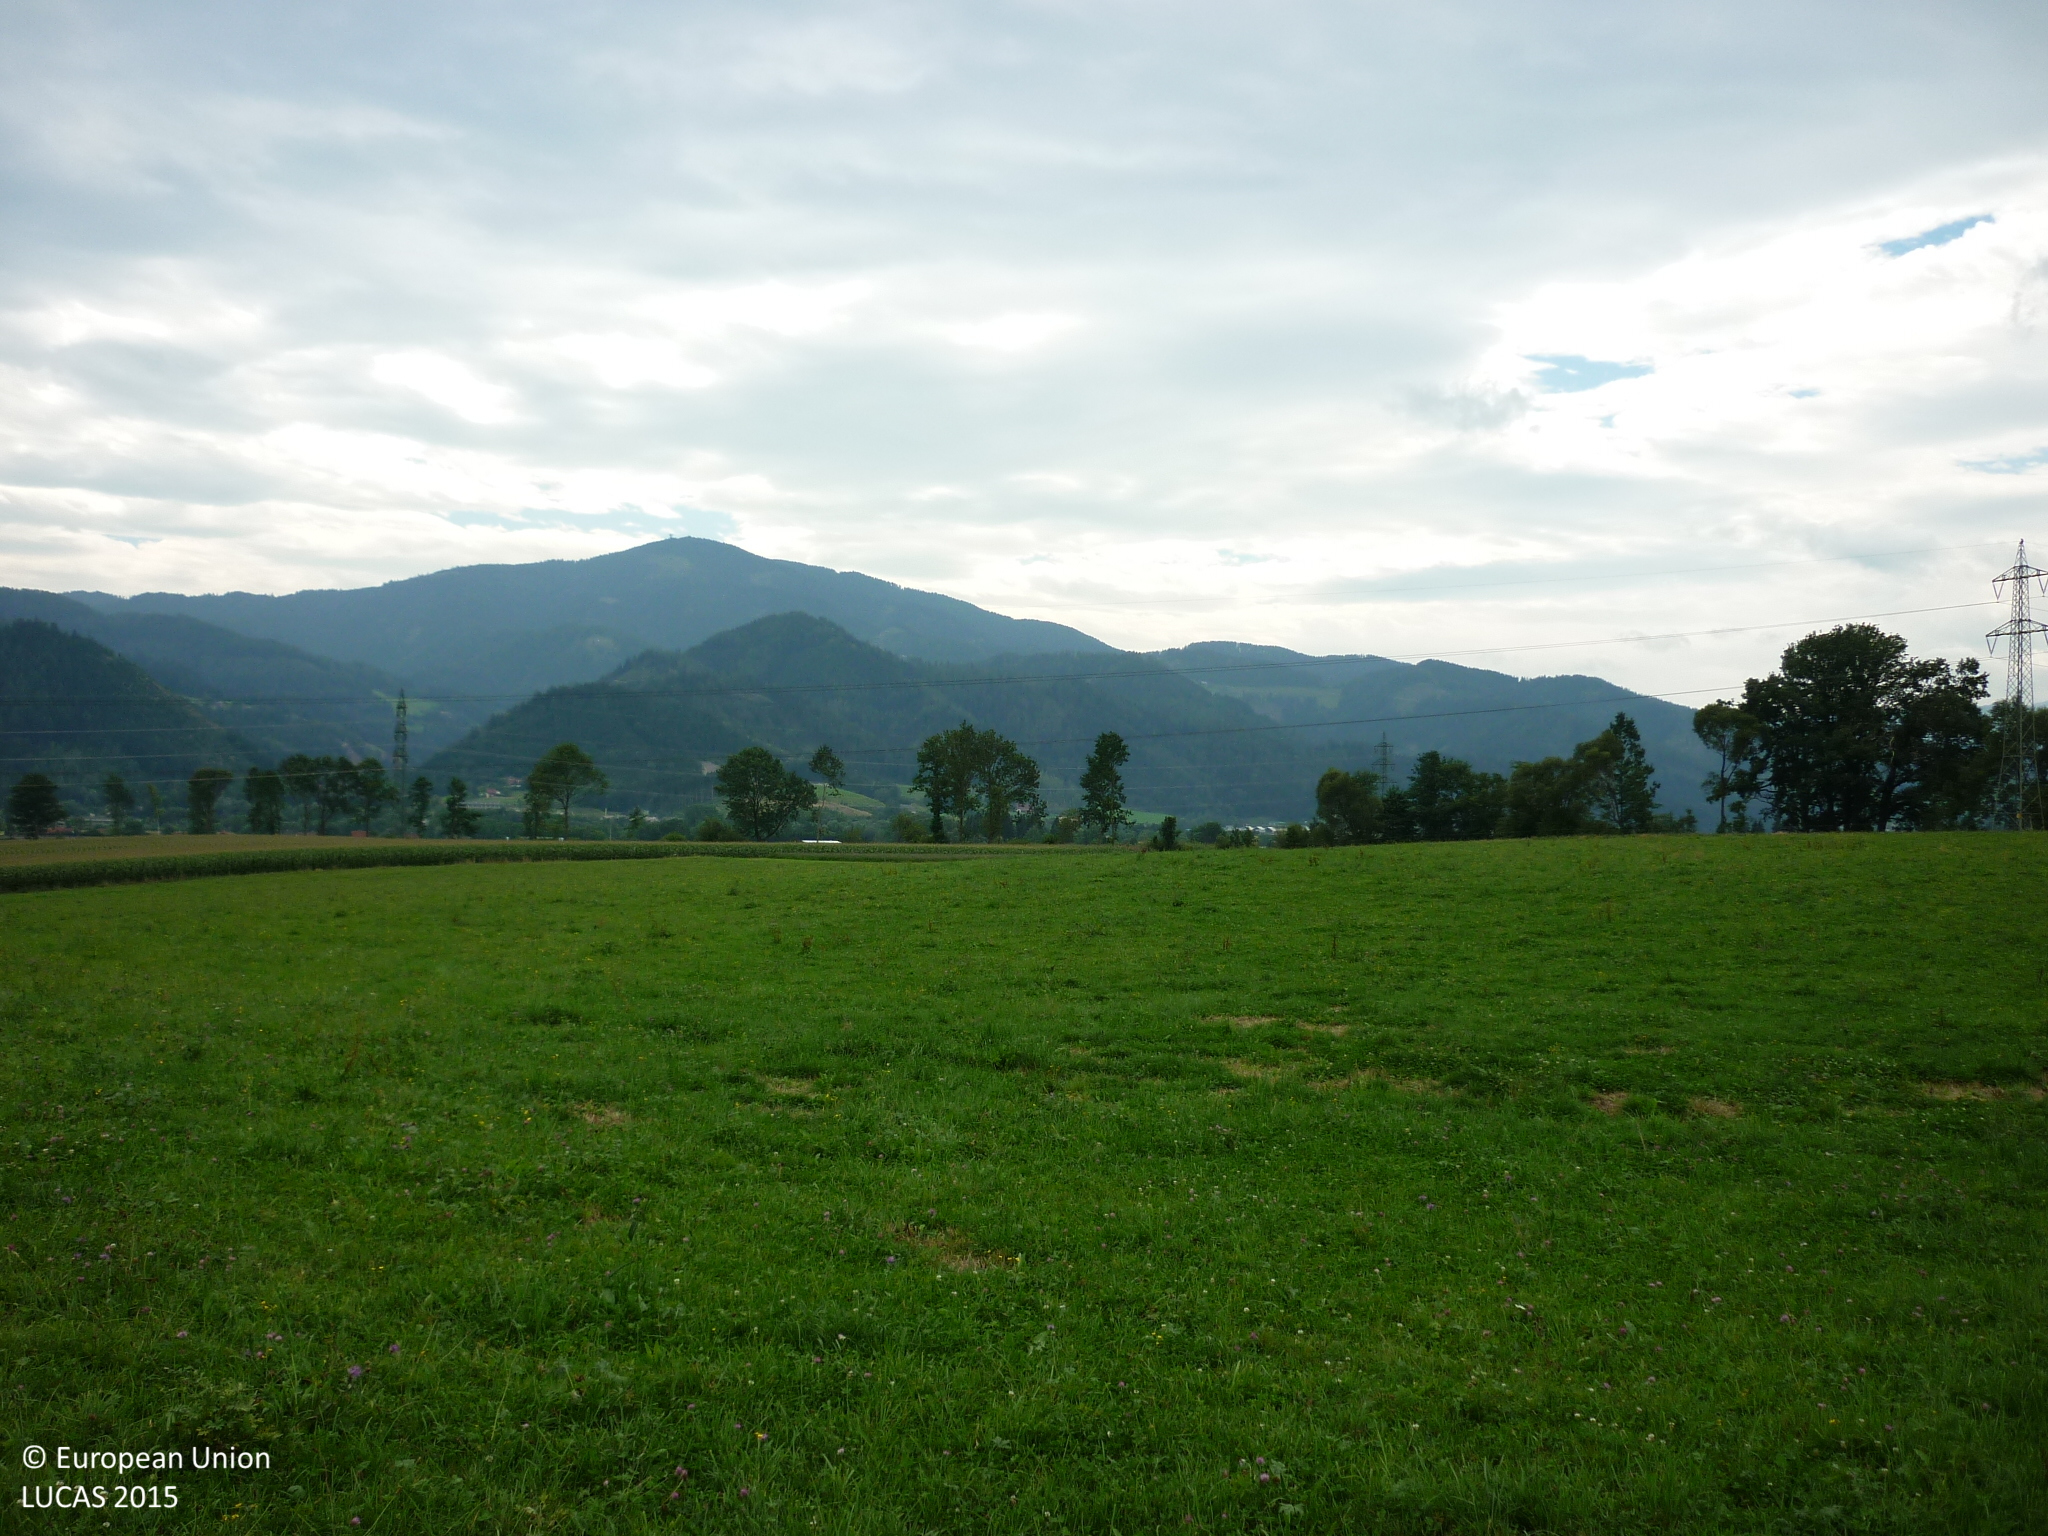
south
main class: Grassland
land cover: Grassland without tree/shrub cover
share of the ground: > 75 %
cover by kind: herbaceous plants 100 %
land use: Agriculture (excluding fallow land and kitchen gardens)
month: August
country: AT
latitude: 47.4805
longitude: 15.3485
